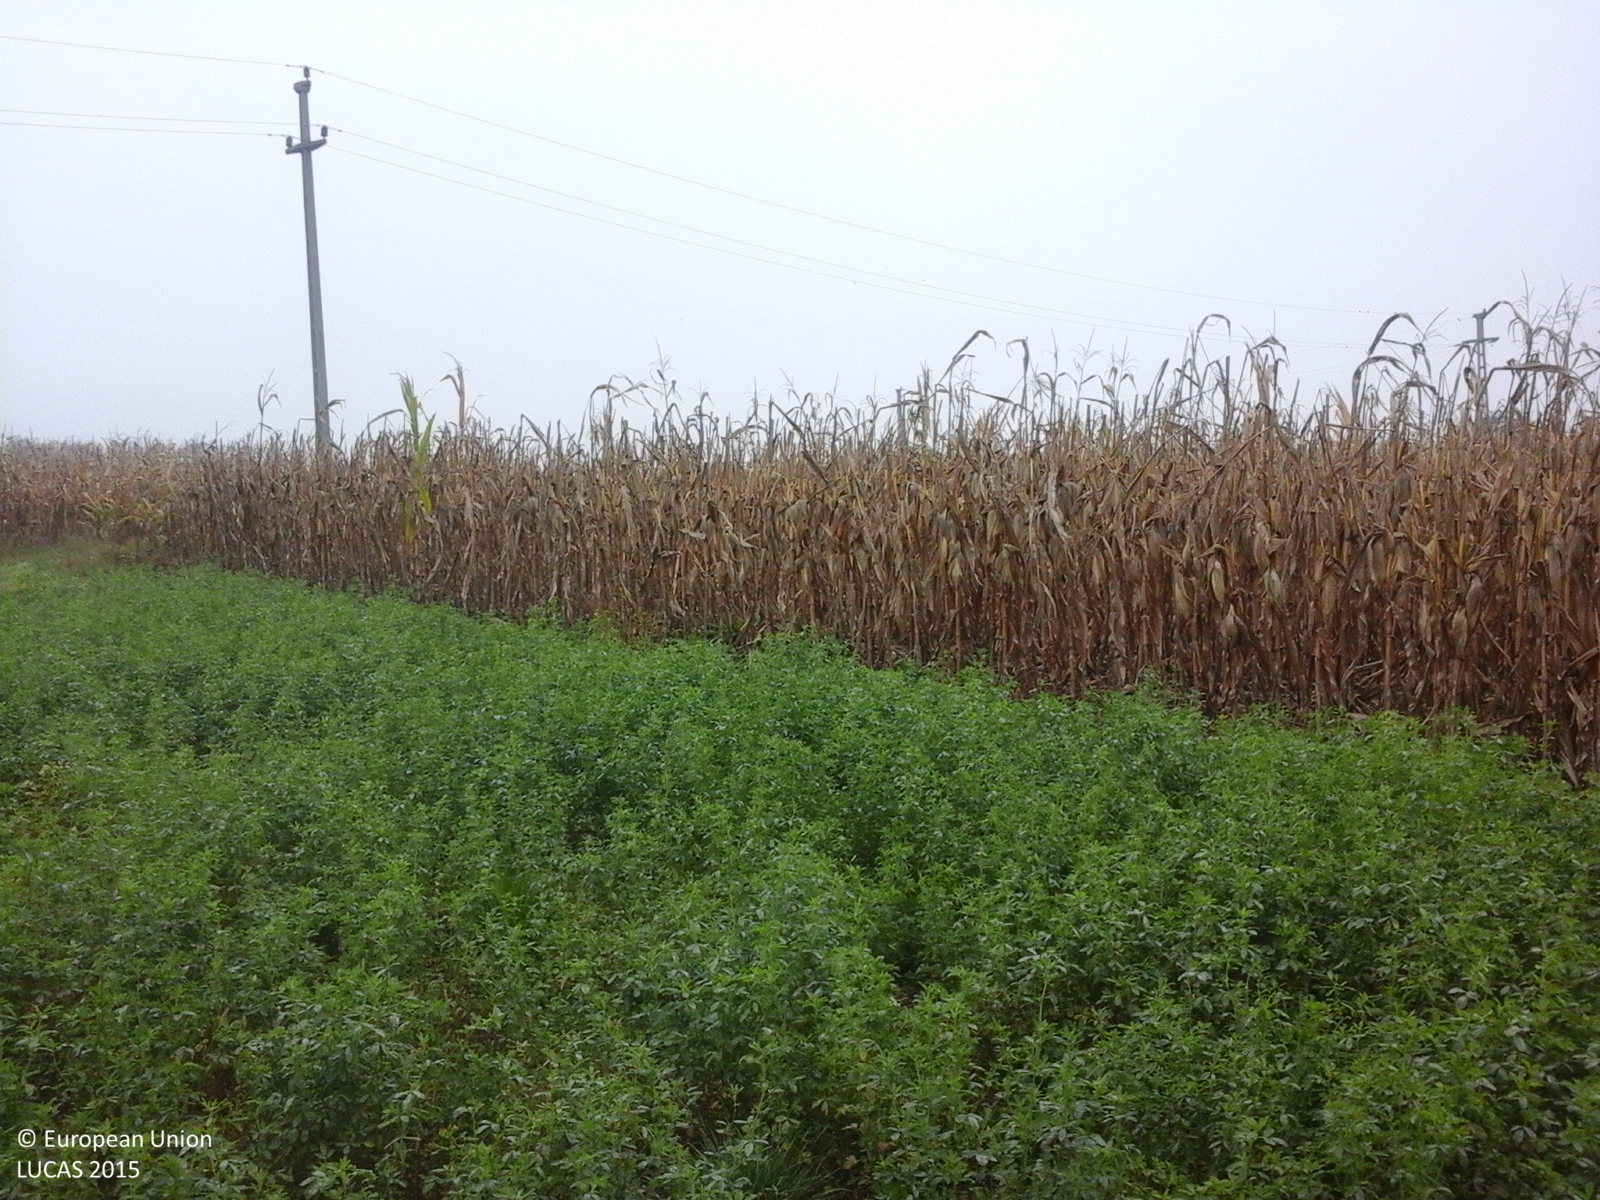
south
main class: Cropland
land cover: Lucerne
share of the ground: > 75 %
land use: Agriculture (excluding fallow land and kitchen gardens)
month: October
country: RO
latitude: 46.5662
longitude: 24.2103
